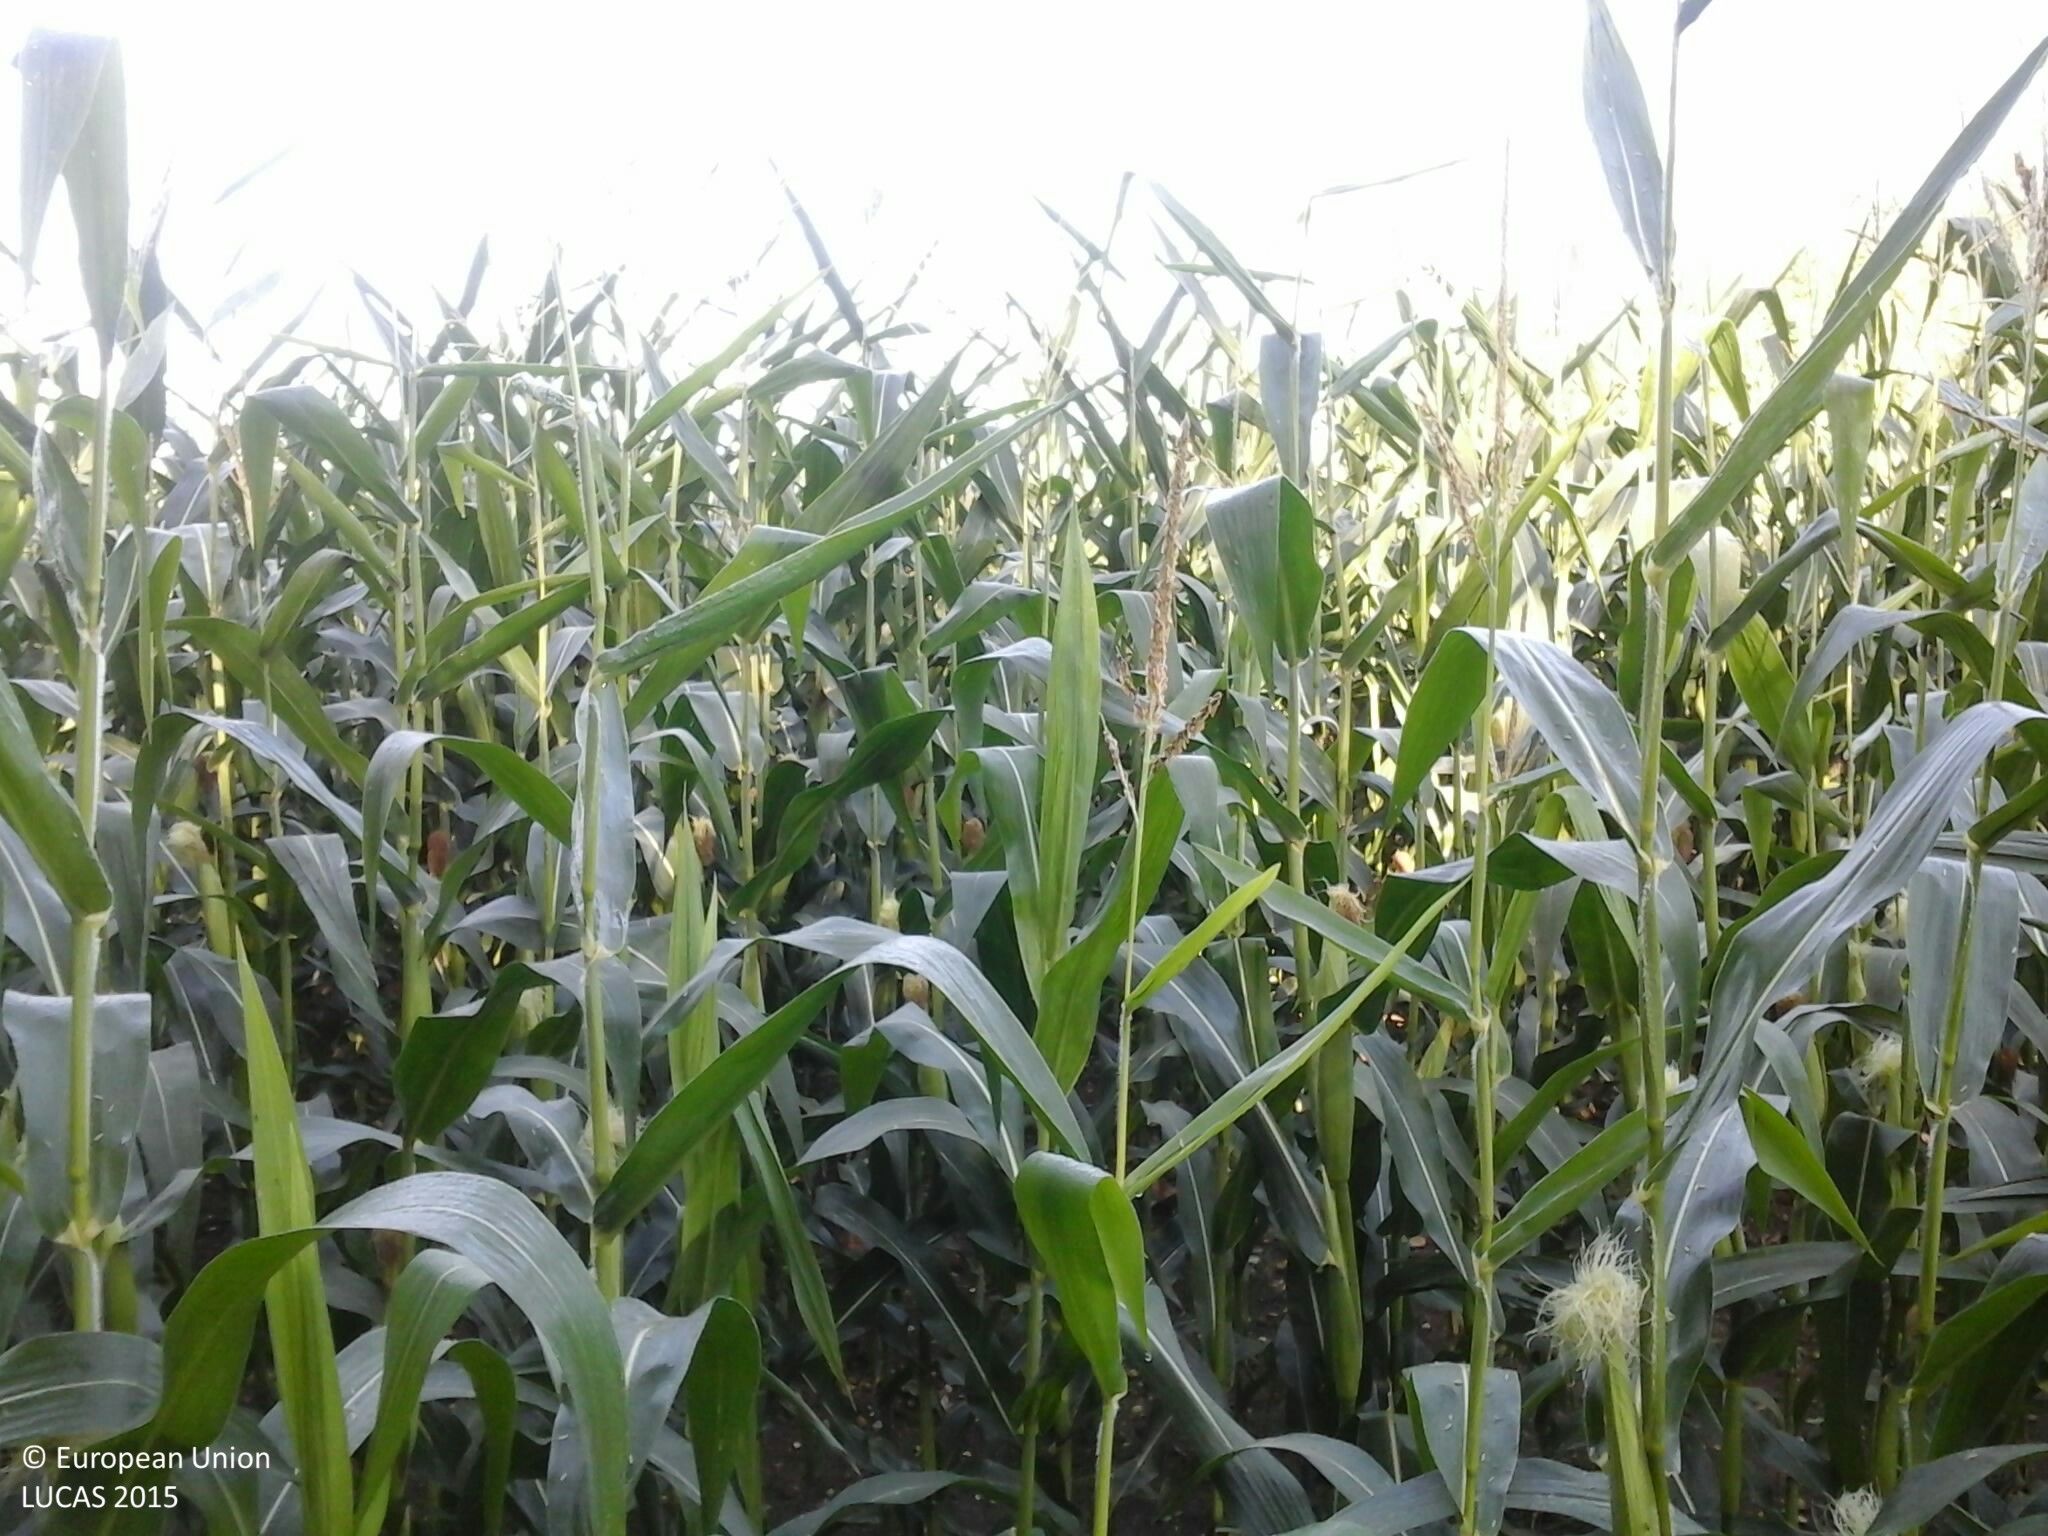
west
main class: Cropland
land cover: Maize
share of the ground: > 75 %
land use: Agriculture (excluding fallow land and kitchen gardens)
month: August
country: HU
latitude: 46.9579
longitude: 16.6390
